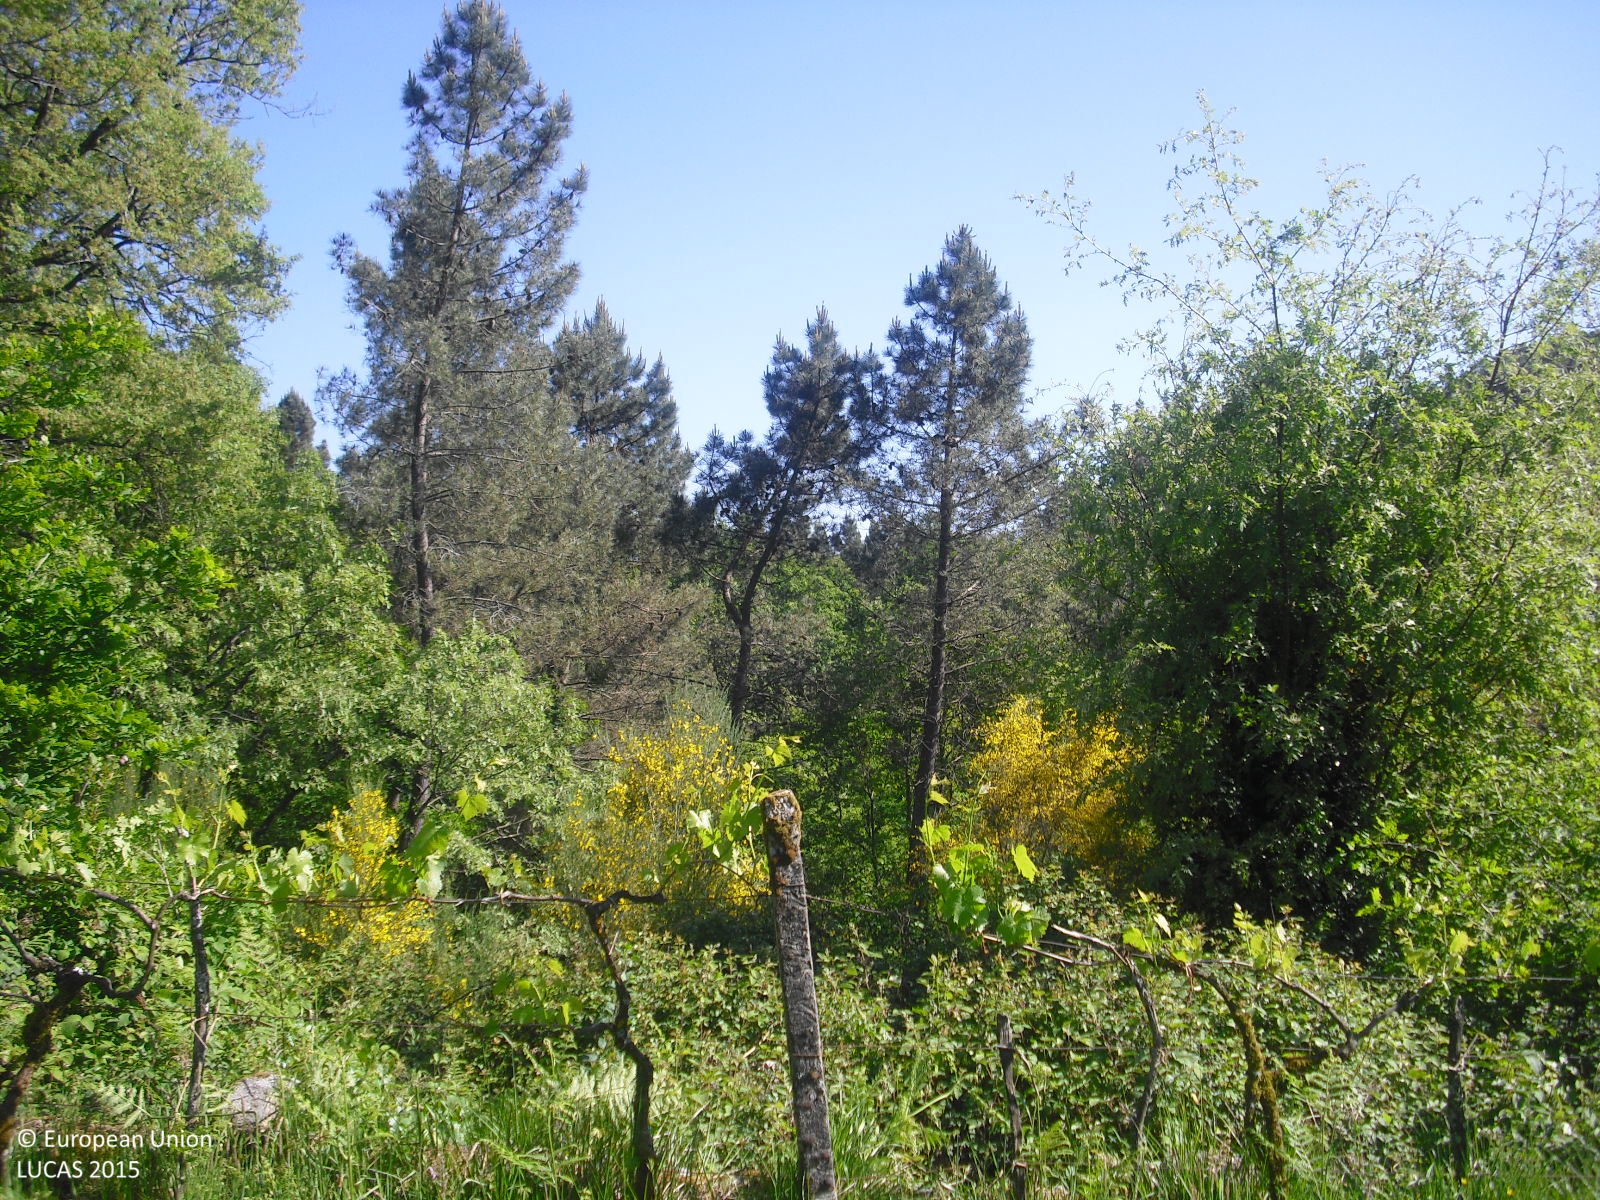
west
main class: Grassland
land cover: Grassland without tree/shrub cover
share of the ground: > 75 %
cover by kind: herbaceous plants 100 %
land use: Agriculture (excluding fallow land and kitchen gardens)
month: May
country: ES
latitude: 41.9596
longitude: -8.1413
